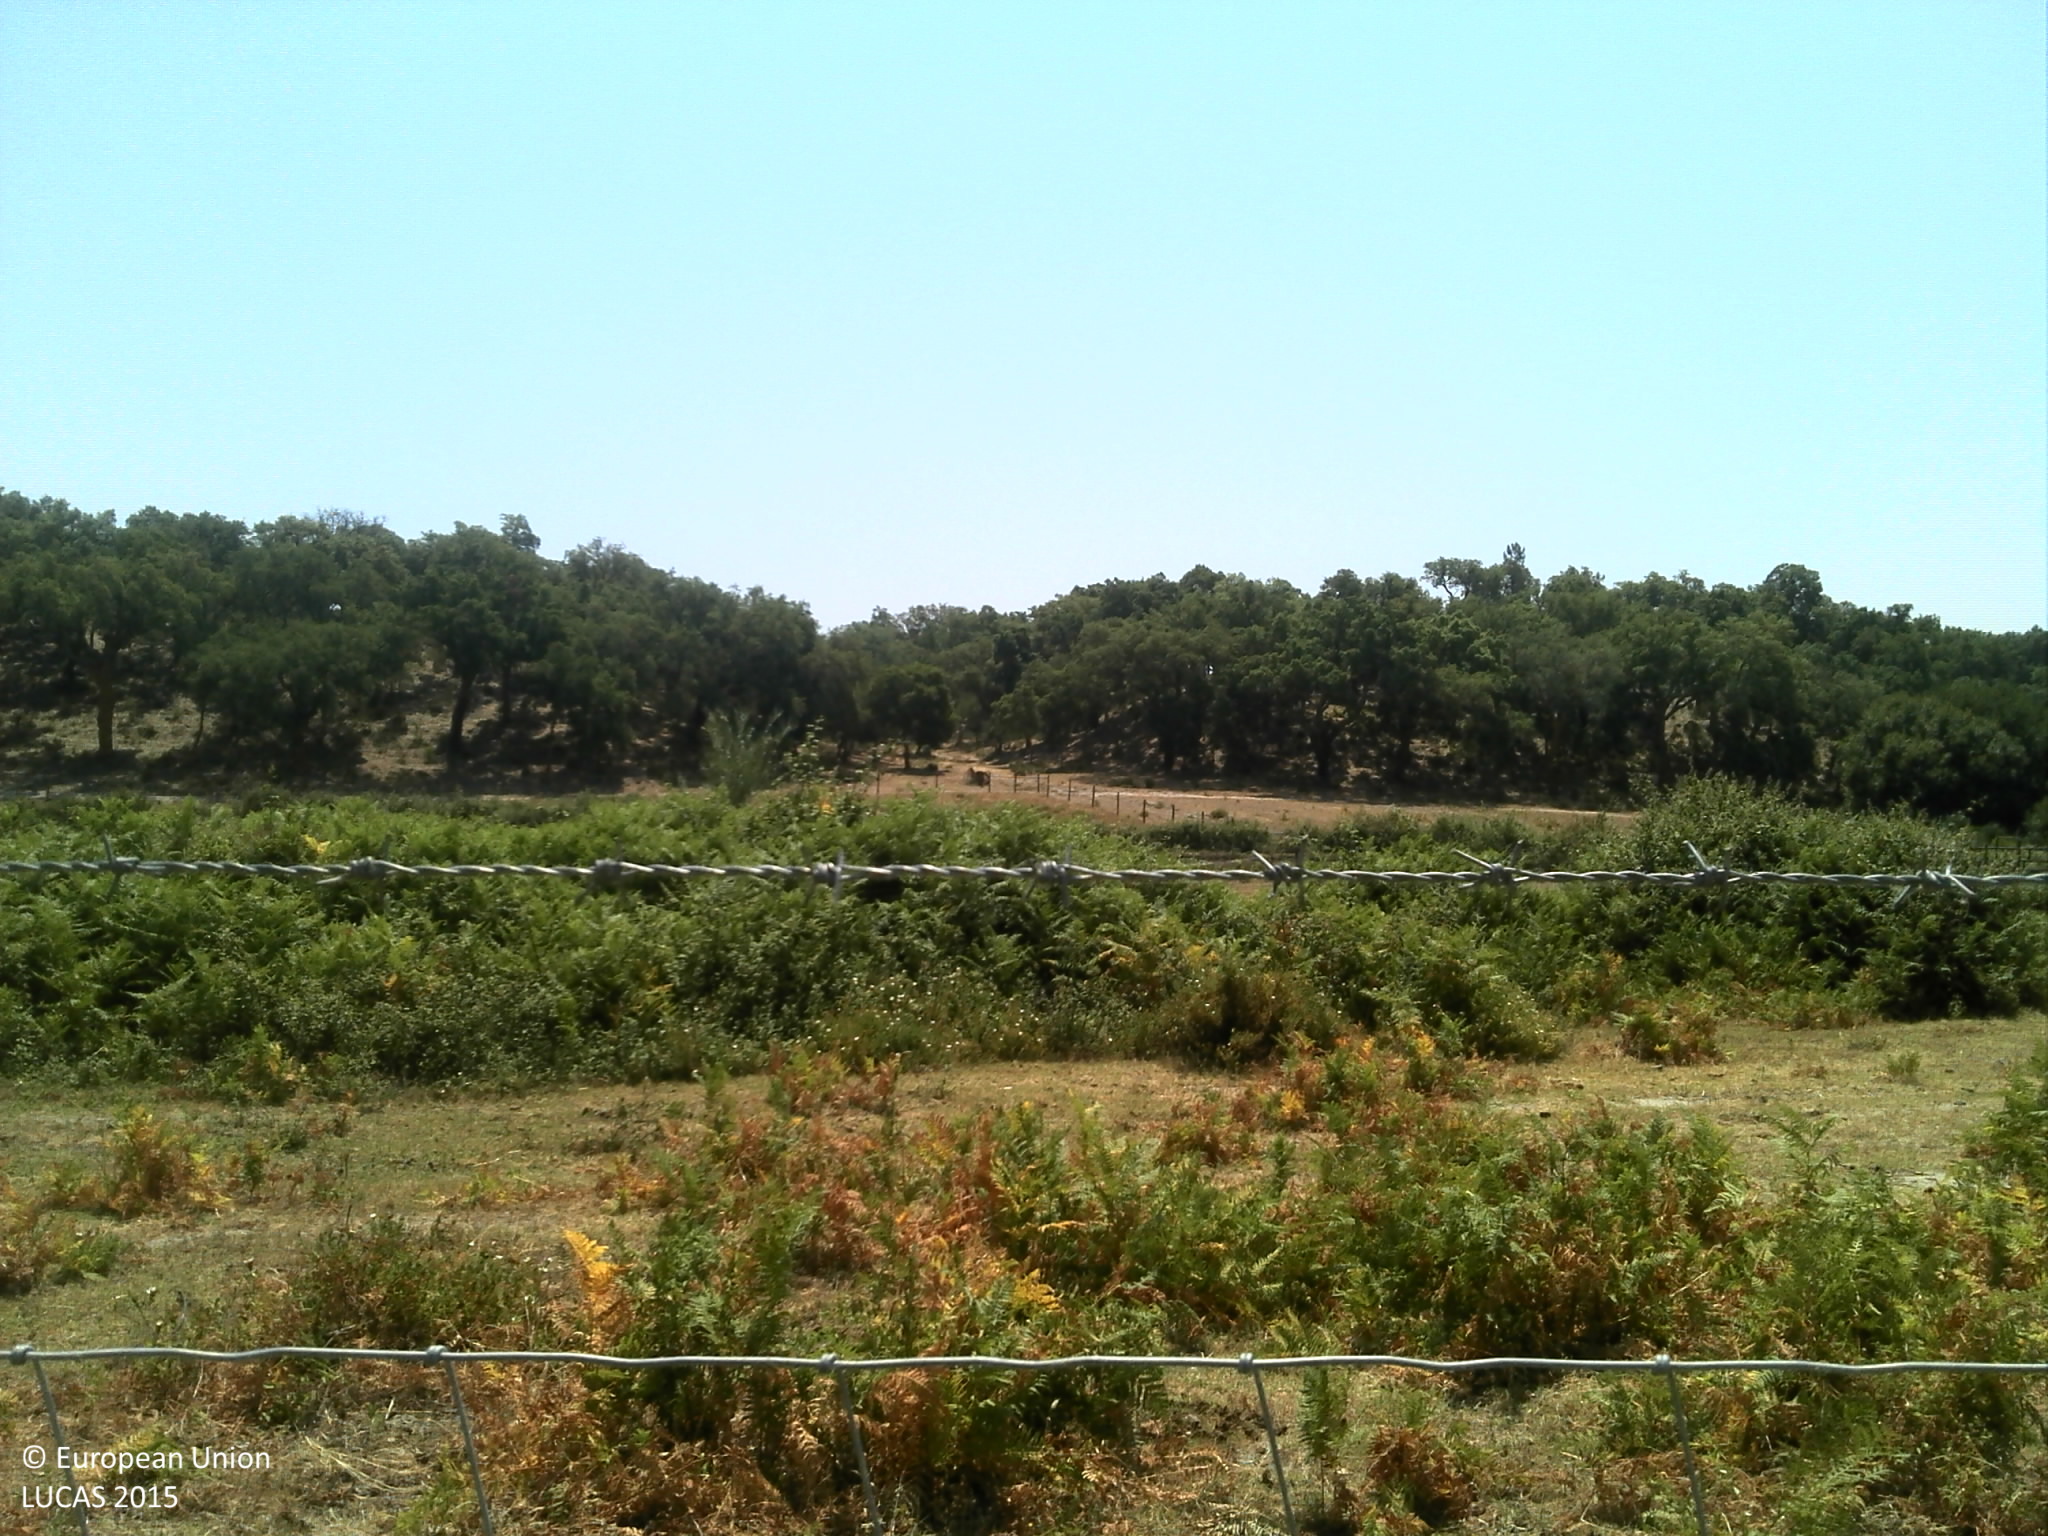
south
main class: Grassland
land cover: Grassland without tree/shrub cover
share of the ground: 50 - 75 %
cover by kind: herbaceous plants 75 %, unconsolidated bare surface 25 %
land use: Agriculture (excluding fallow land and kitchen gardens)
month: June
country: PT
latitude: 39.3914
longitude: -7.9483
